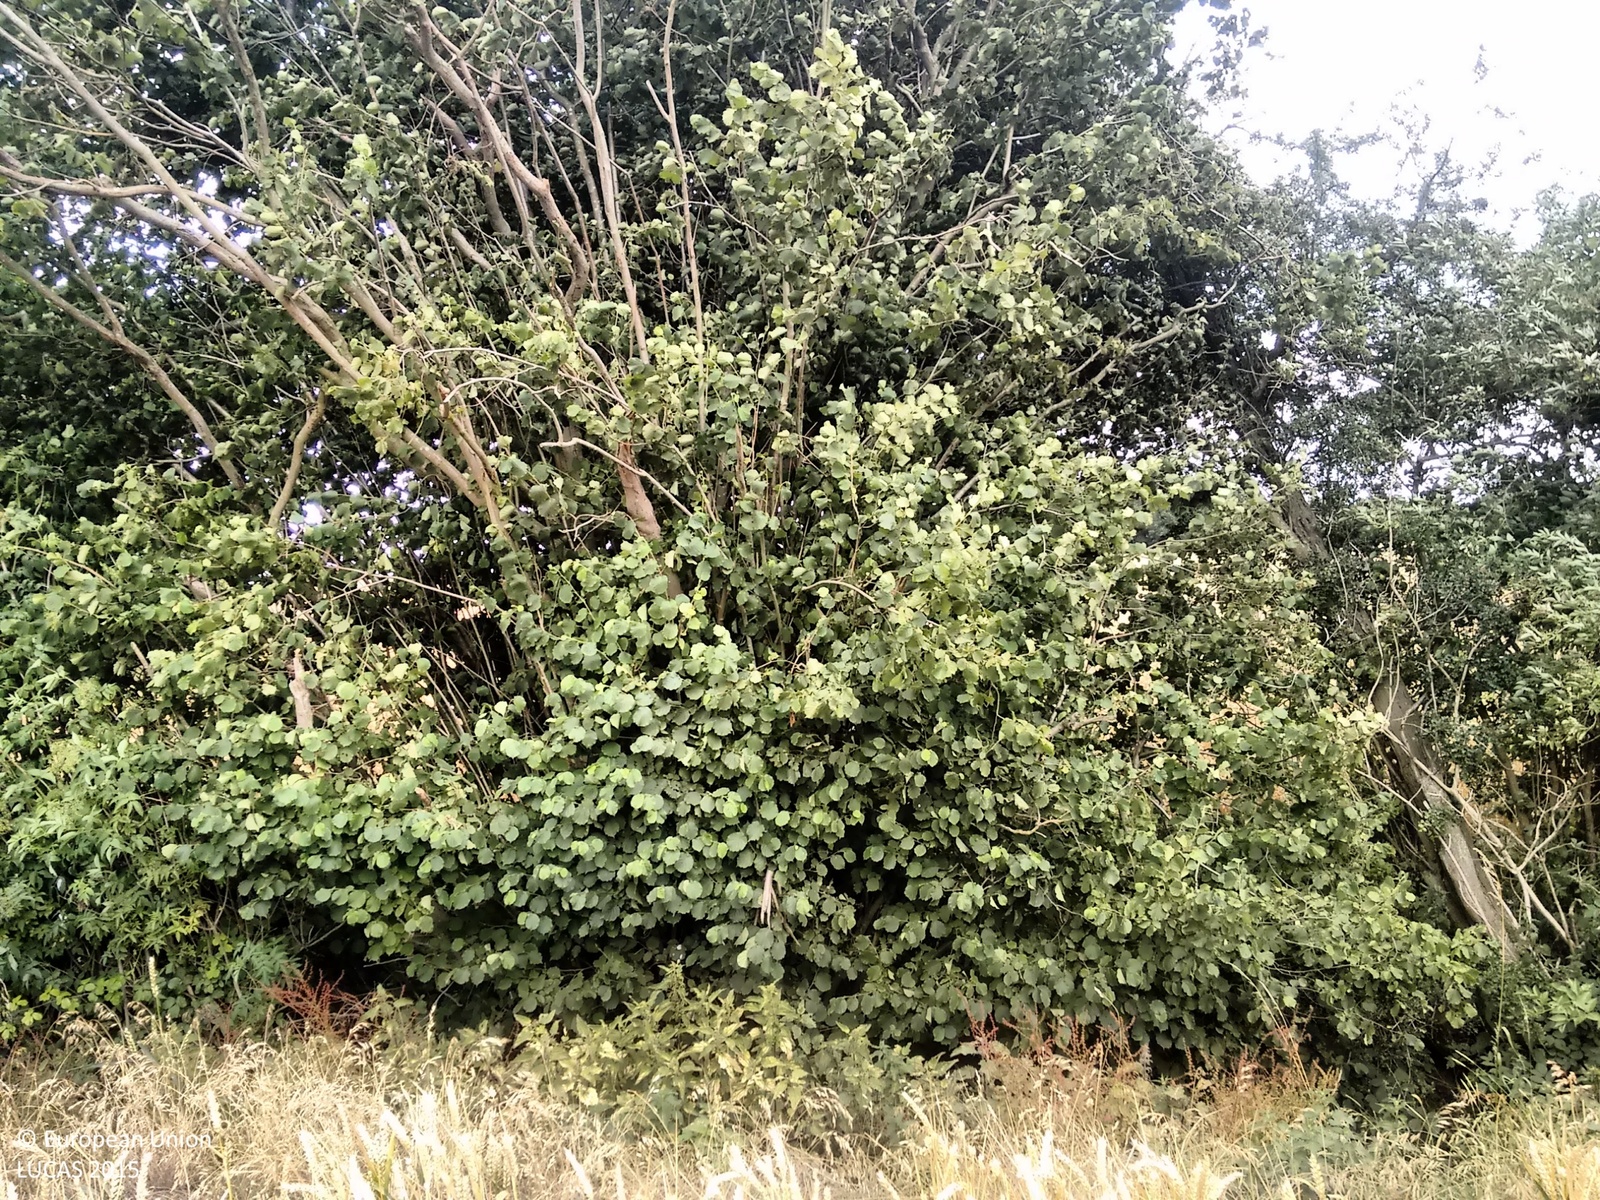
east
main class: Cropland
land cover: Common wheat
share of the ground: 50 - 75 %
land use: Agriculture (excluding fallow land and kitchen gardens)
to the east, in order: Common wheat; Grass margins; Ditches and canals; Managed hedges; Grass margins; Common wheat; Grass margins; Managed hedges; Ditches and canals; Grassland without tree/shrub cover
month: August
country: GB
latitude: 51.9594
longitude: 0.4985
